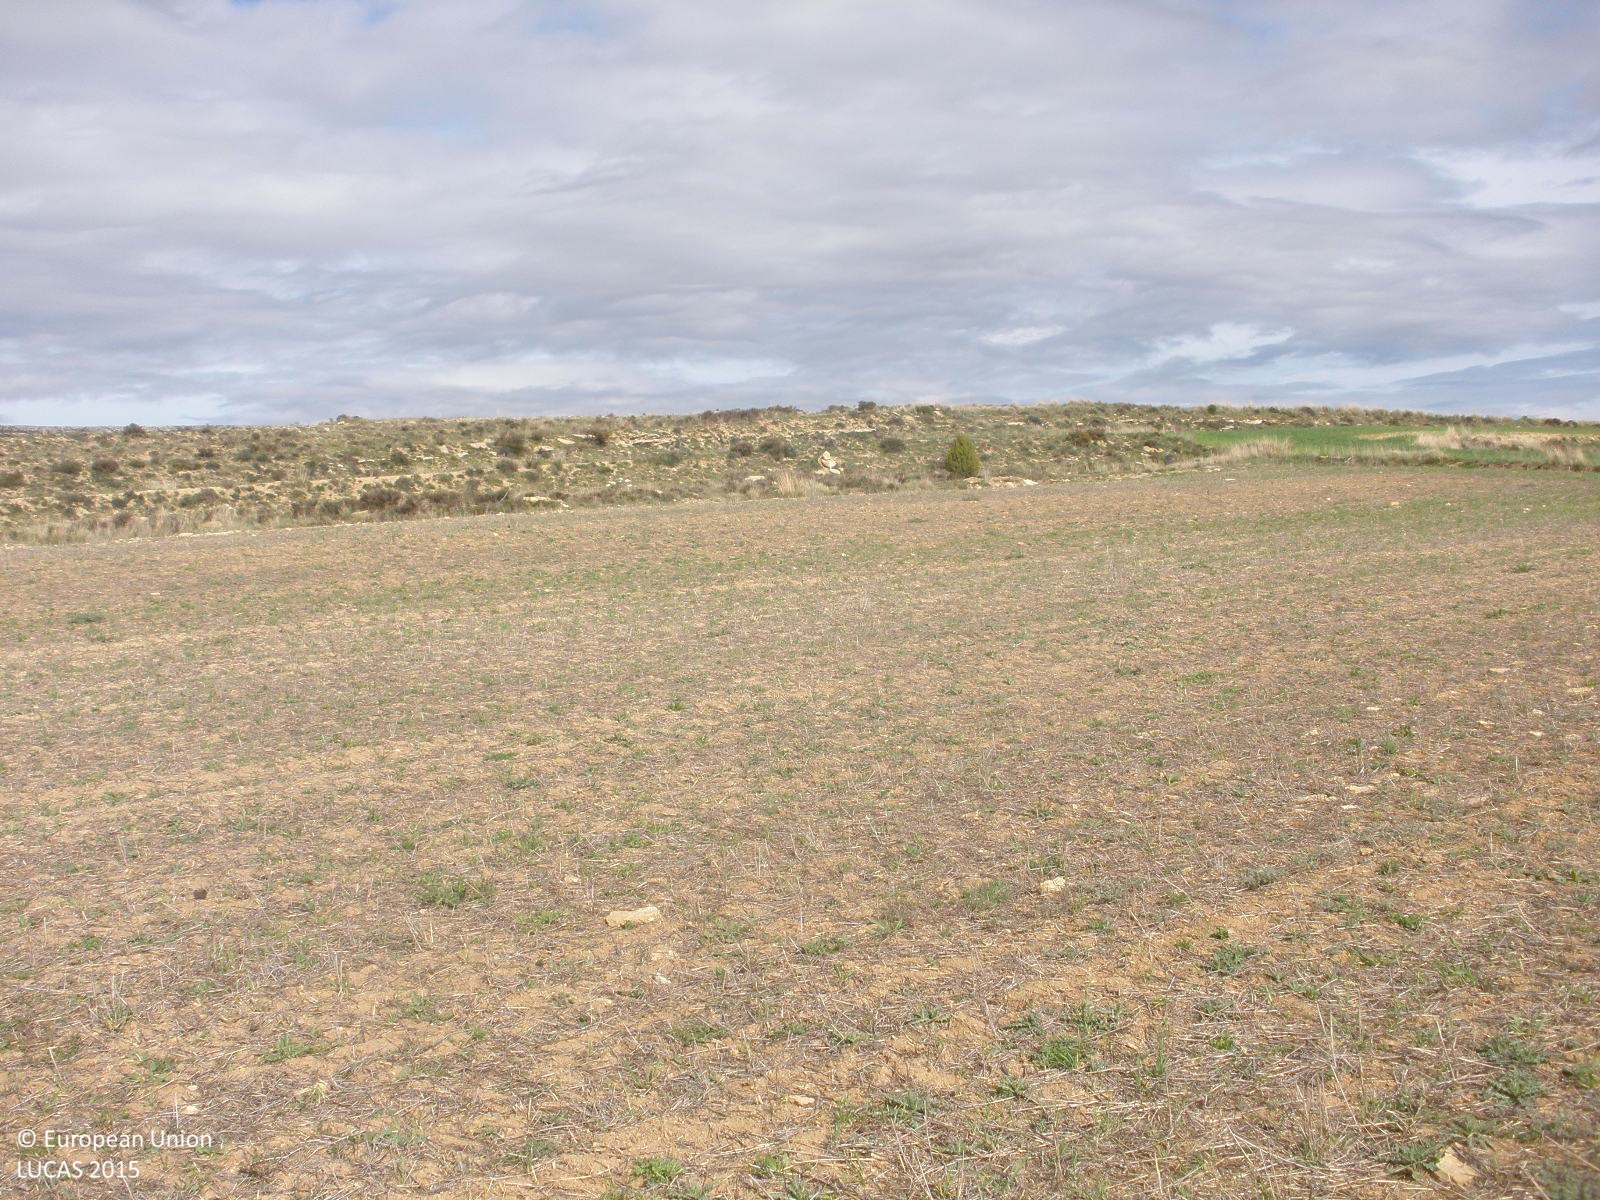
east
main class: Grassland
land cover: Spontaneously vegetated surfaces
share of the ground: 25 - 50 %
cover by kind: unconsolidated bare surface 60 %, herbaceous plants 40 %
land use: Agriculture (excluding fallow land and kitchen gardens)
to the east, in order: Spontaneously vegetated surfaces; Shrubland without tree cover; Spontaneously vegetated surfaces; Shrubland without tree cover; Spontaneously vegetated surfaces; Shrubland without tree cover; Spontaneously vegetated surfaces; Shrubland without tree cover; Spontaneously vegetated surfaces
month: May
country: ES
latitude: 40.5661
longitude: -0.7708
